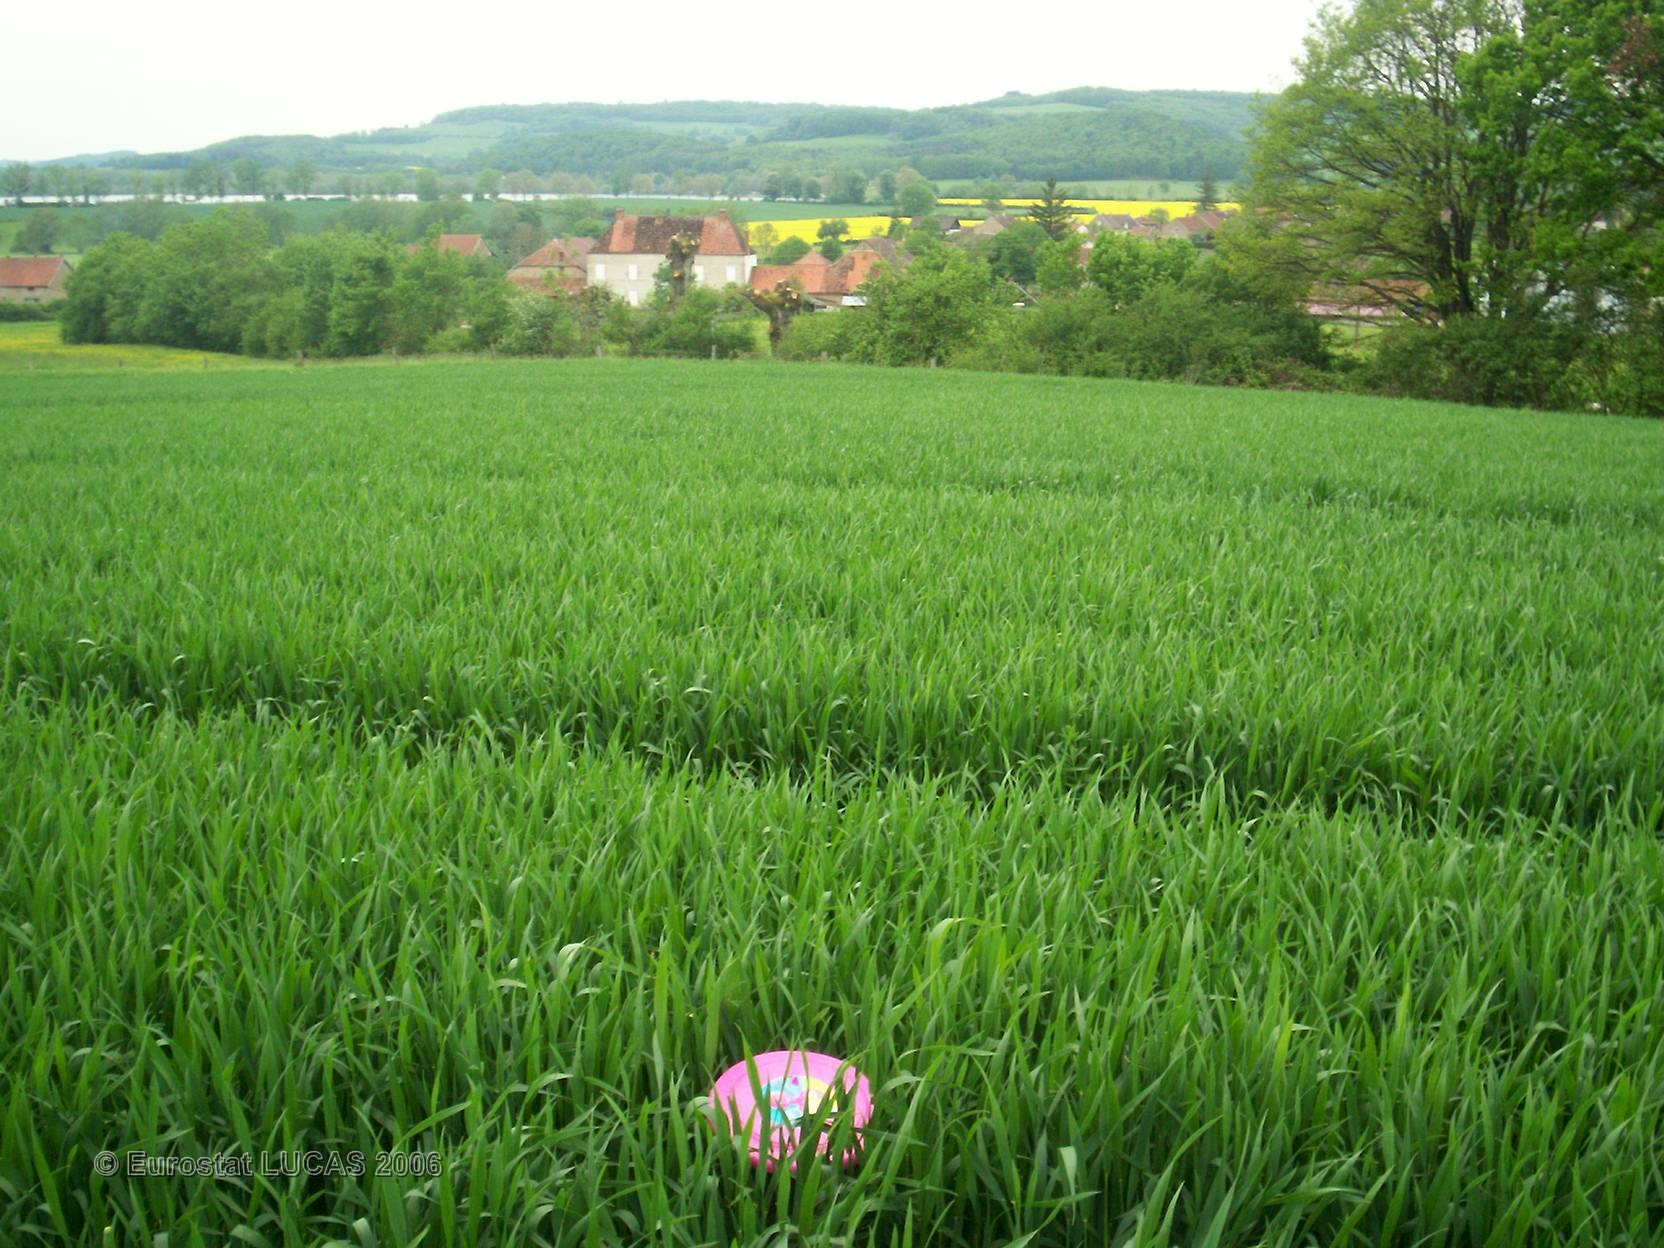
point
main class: Cropland
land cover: Common wheat
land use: Agriculture (excluding fallow land and kitchen gardens)
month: May
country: FR
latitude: 47.2459
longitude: 4.6492
